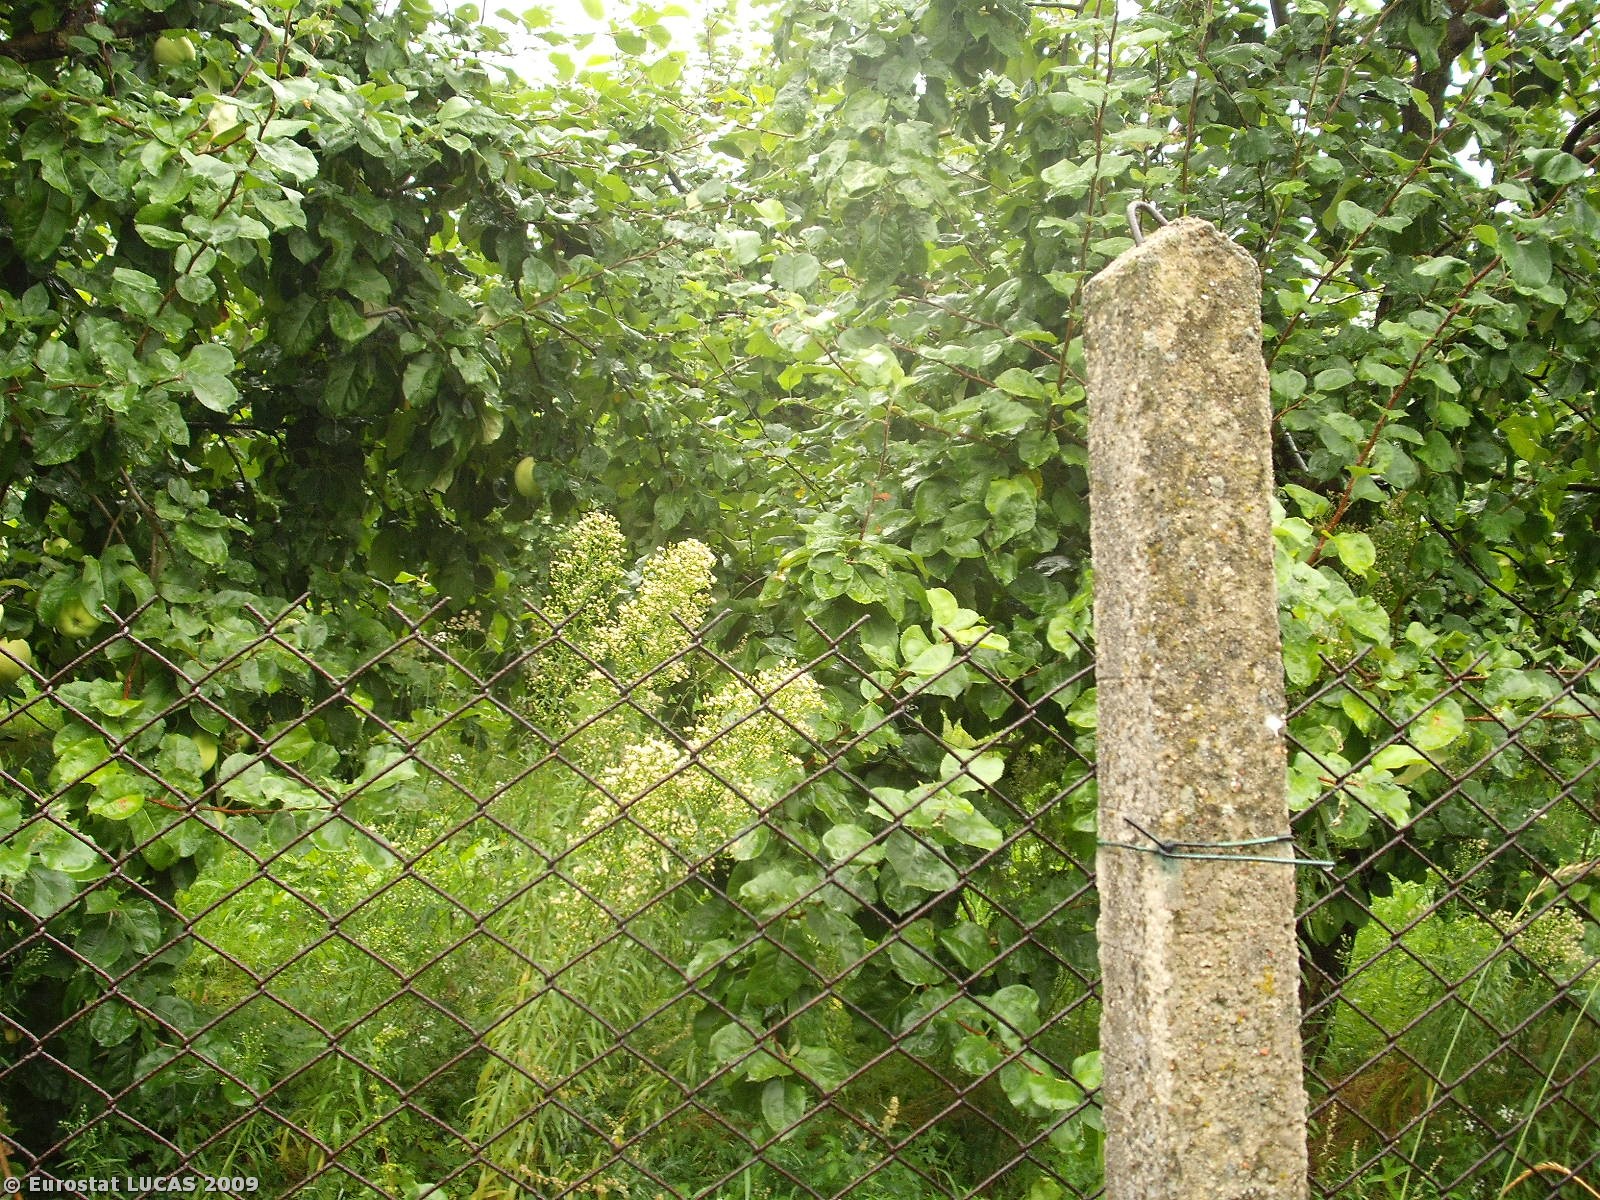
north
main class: Cropland
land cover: Apple fruit
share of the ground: > 75 %
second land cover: Grassland with sparse tree/shrub cover
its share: > 75 %
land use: Agriculture (excluding fallow land and kitchen gardens)
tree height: < 5 m
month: August
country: PL
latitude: 51.9211
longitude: 21.1699
